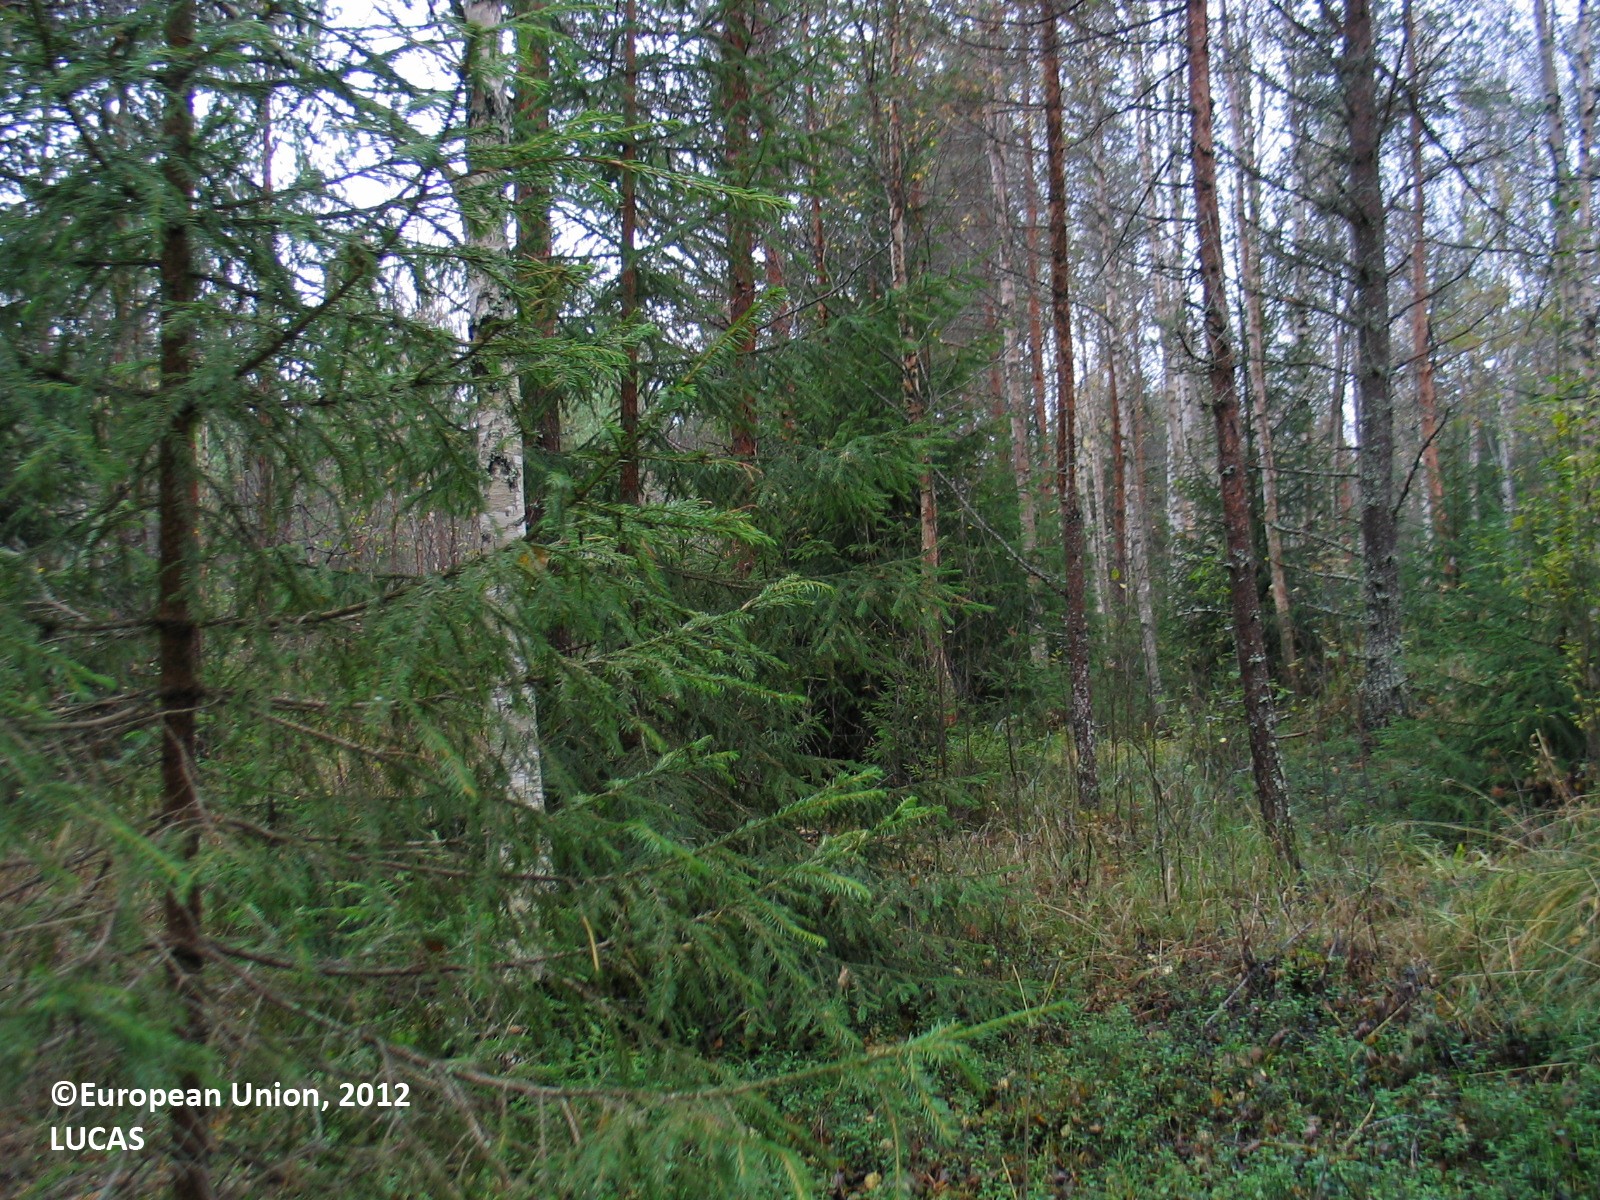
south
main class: Woodland
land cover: Other mixed woodland
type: boreal forest
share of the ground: 50 - 75 %
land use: Forestry
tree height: > 5 m
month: September
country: FI
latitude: 65.3513
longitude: 25.4868
